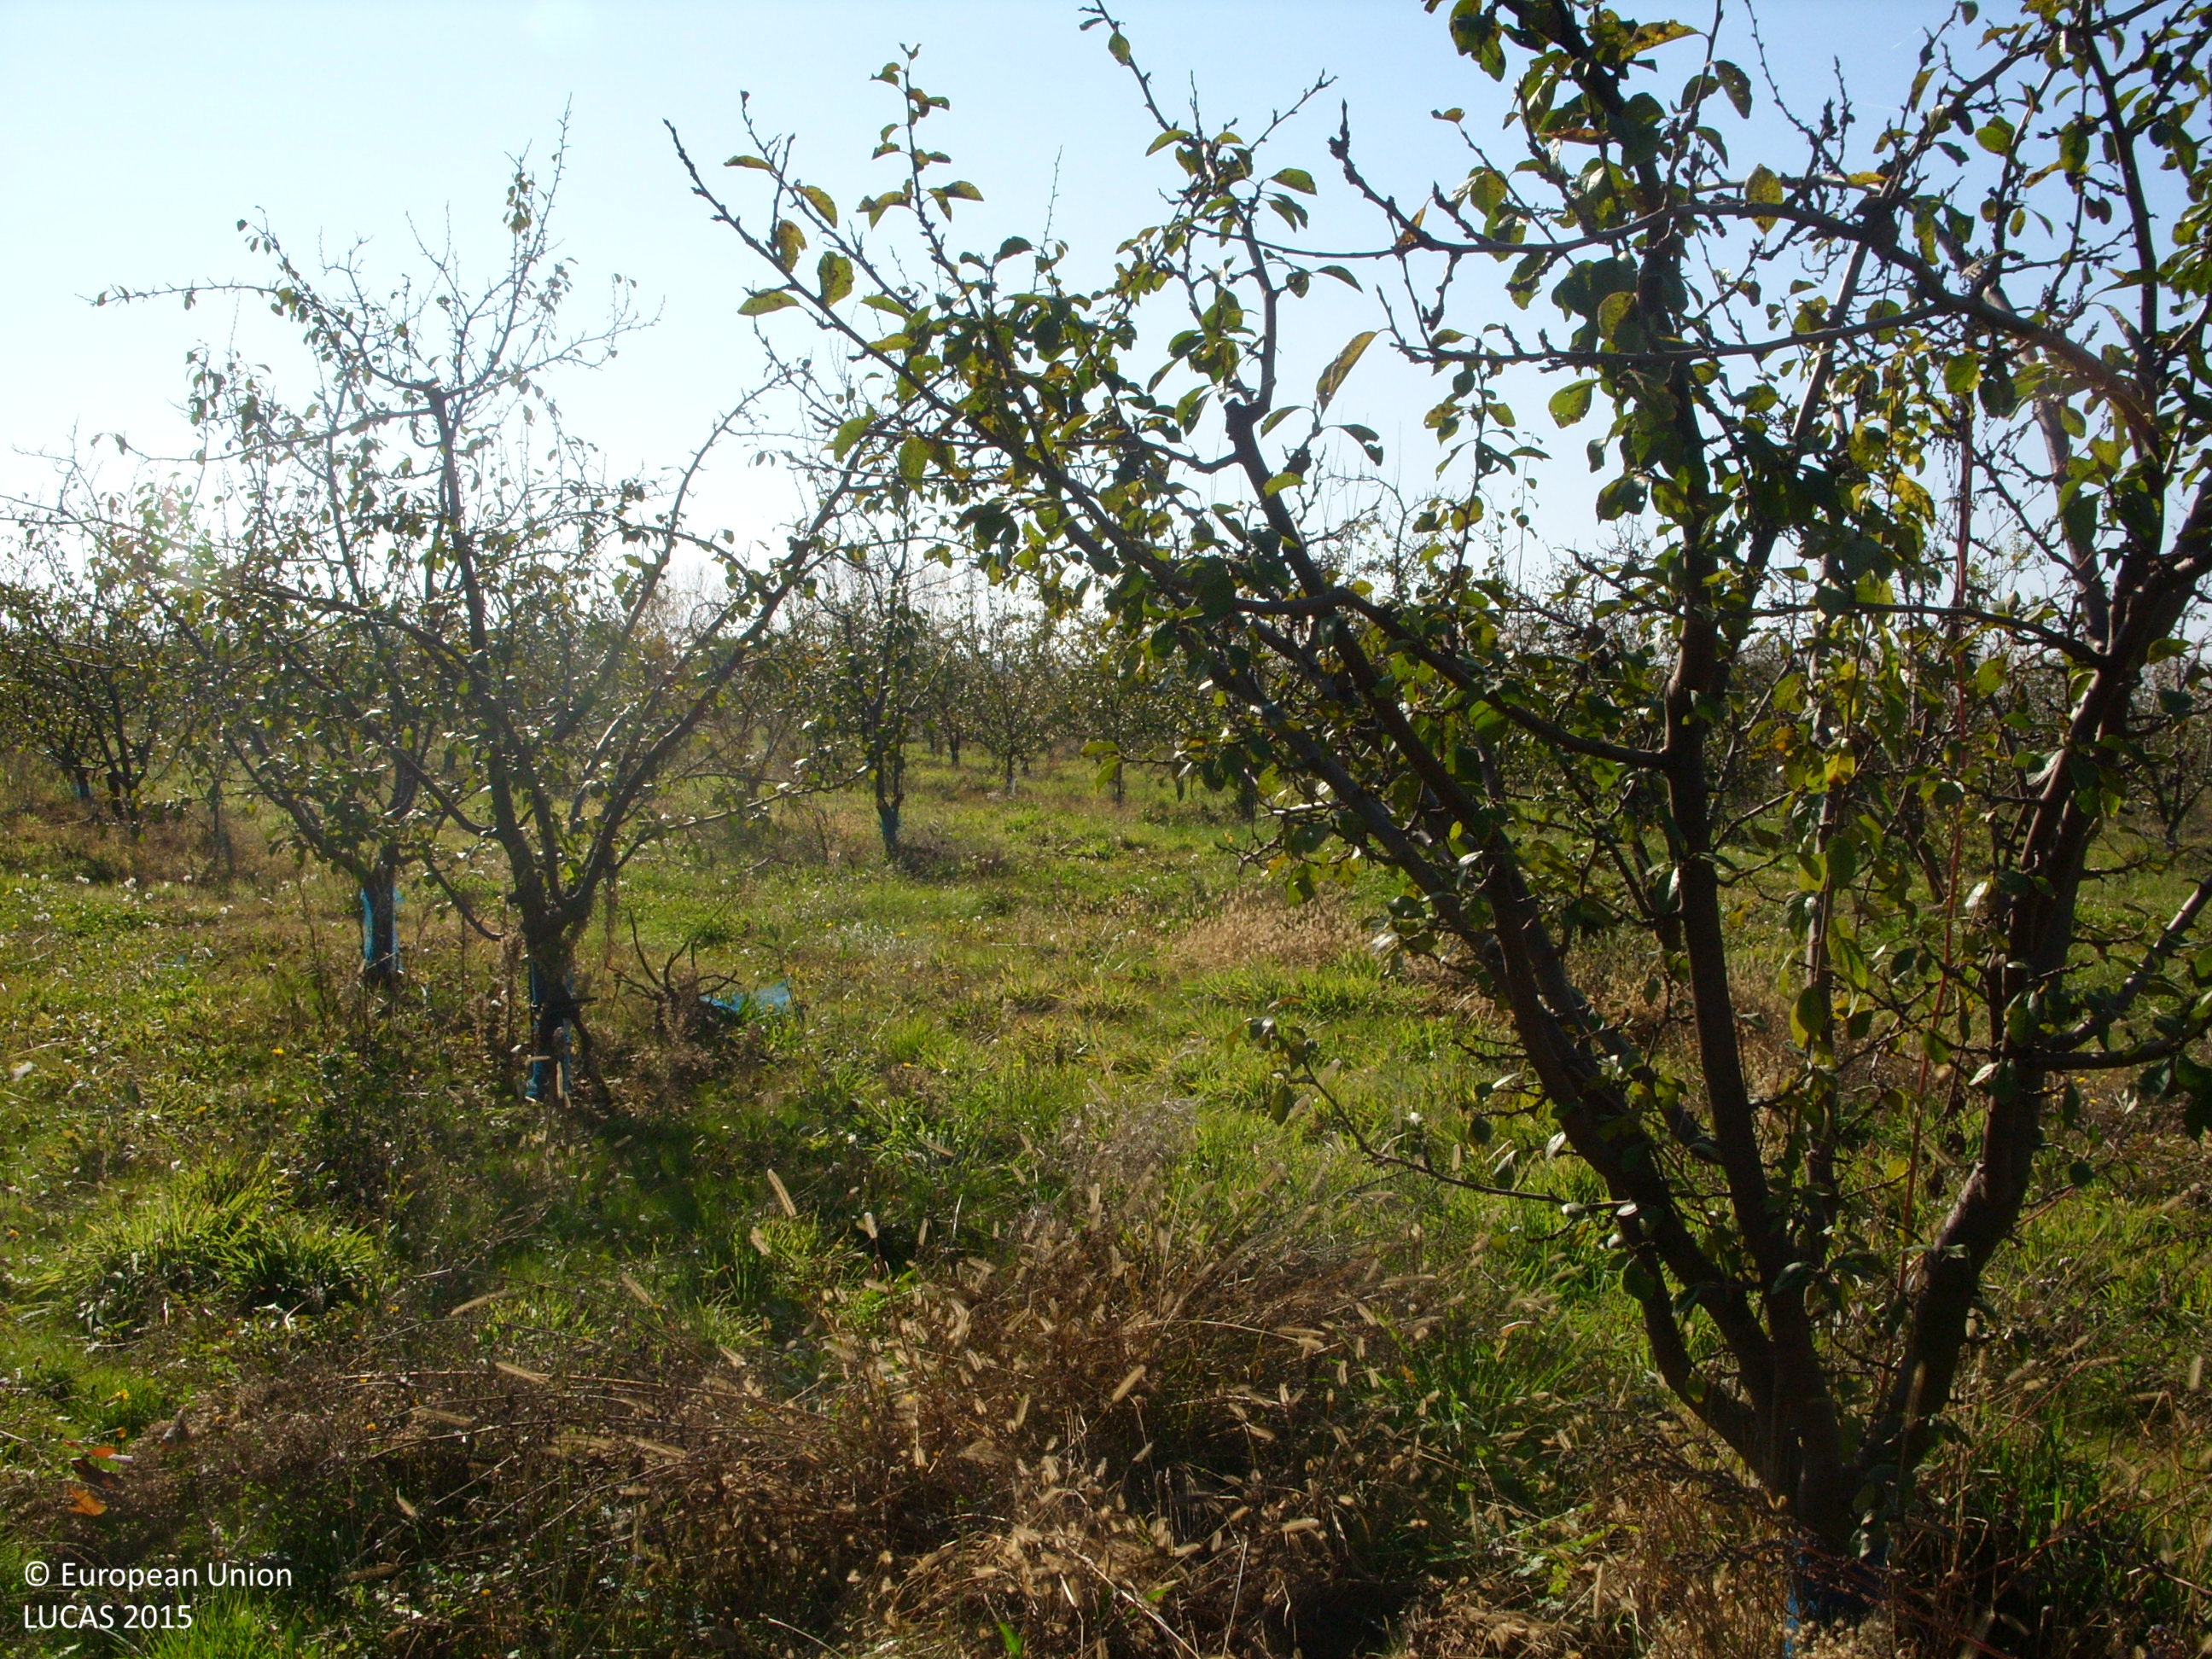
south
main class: Cropland
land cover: Other fruit trees and berries
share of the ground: 10 - 25 %
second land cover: Spontaneously vegetated surfaces
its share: > 75 %
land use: Agriculture (excluding fallow land and kitchen gardens)
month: November
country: BG
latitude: 42.4569
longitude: 24.6825
